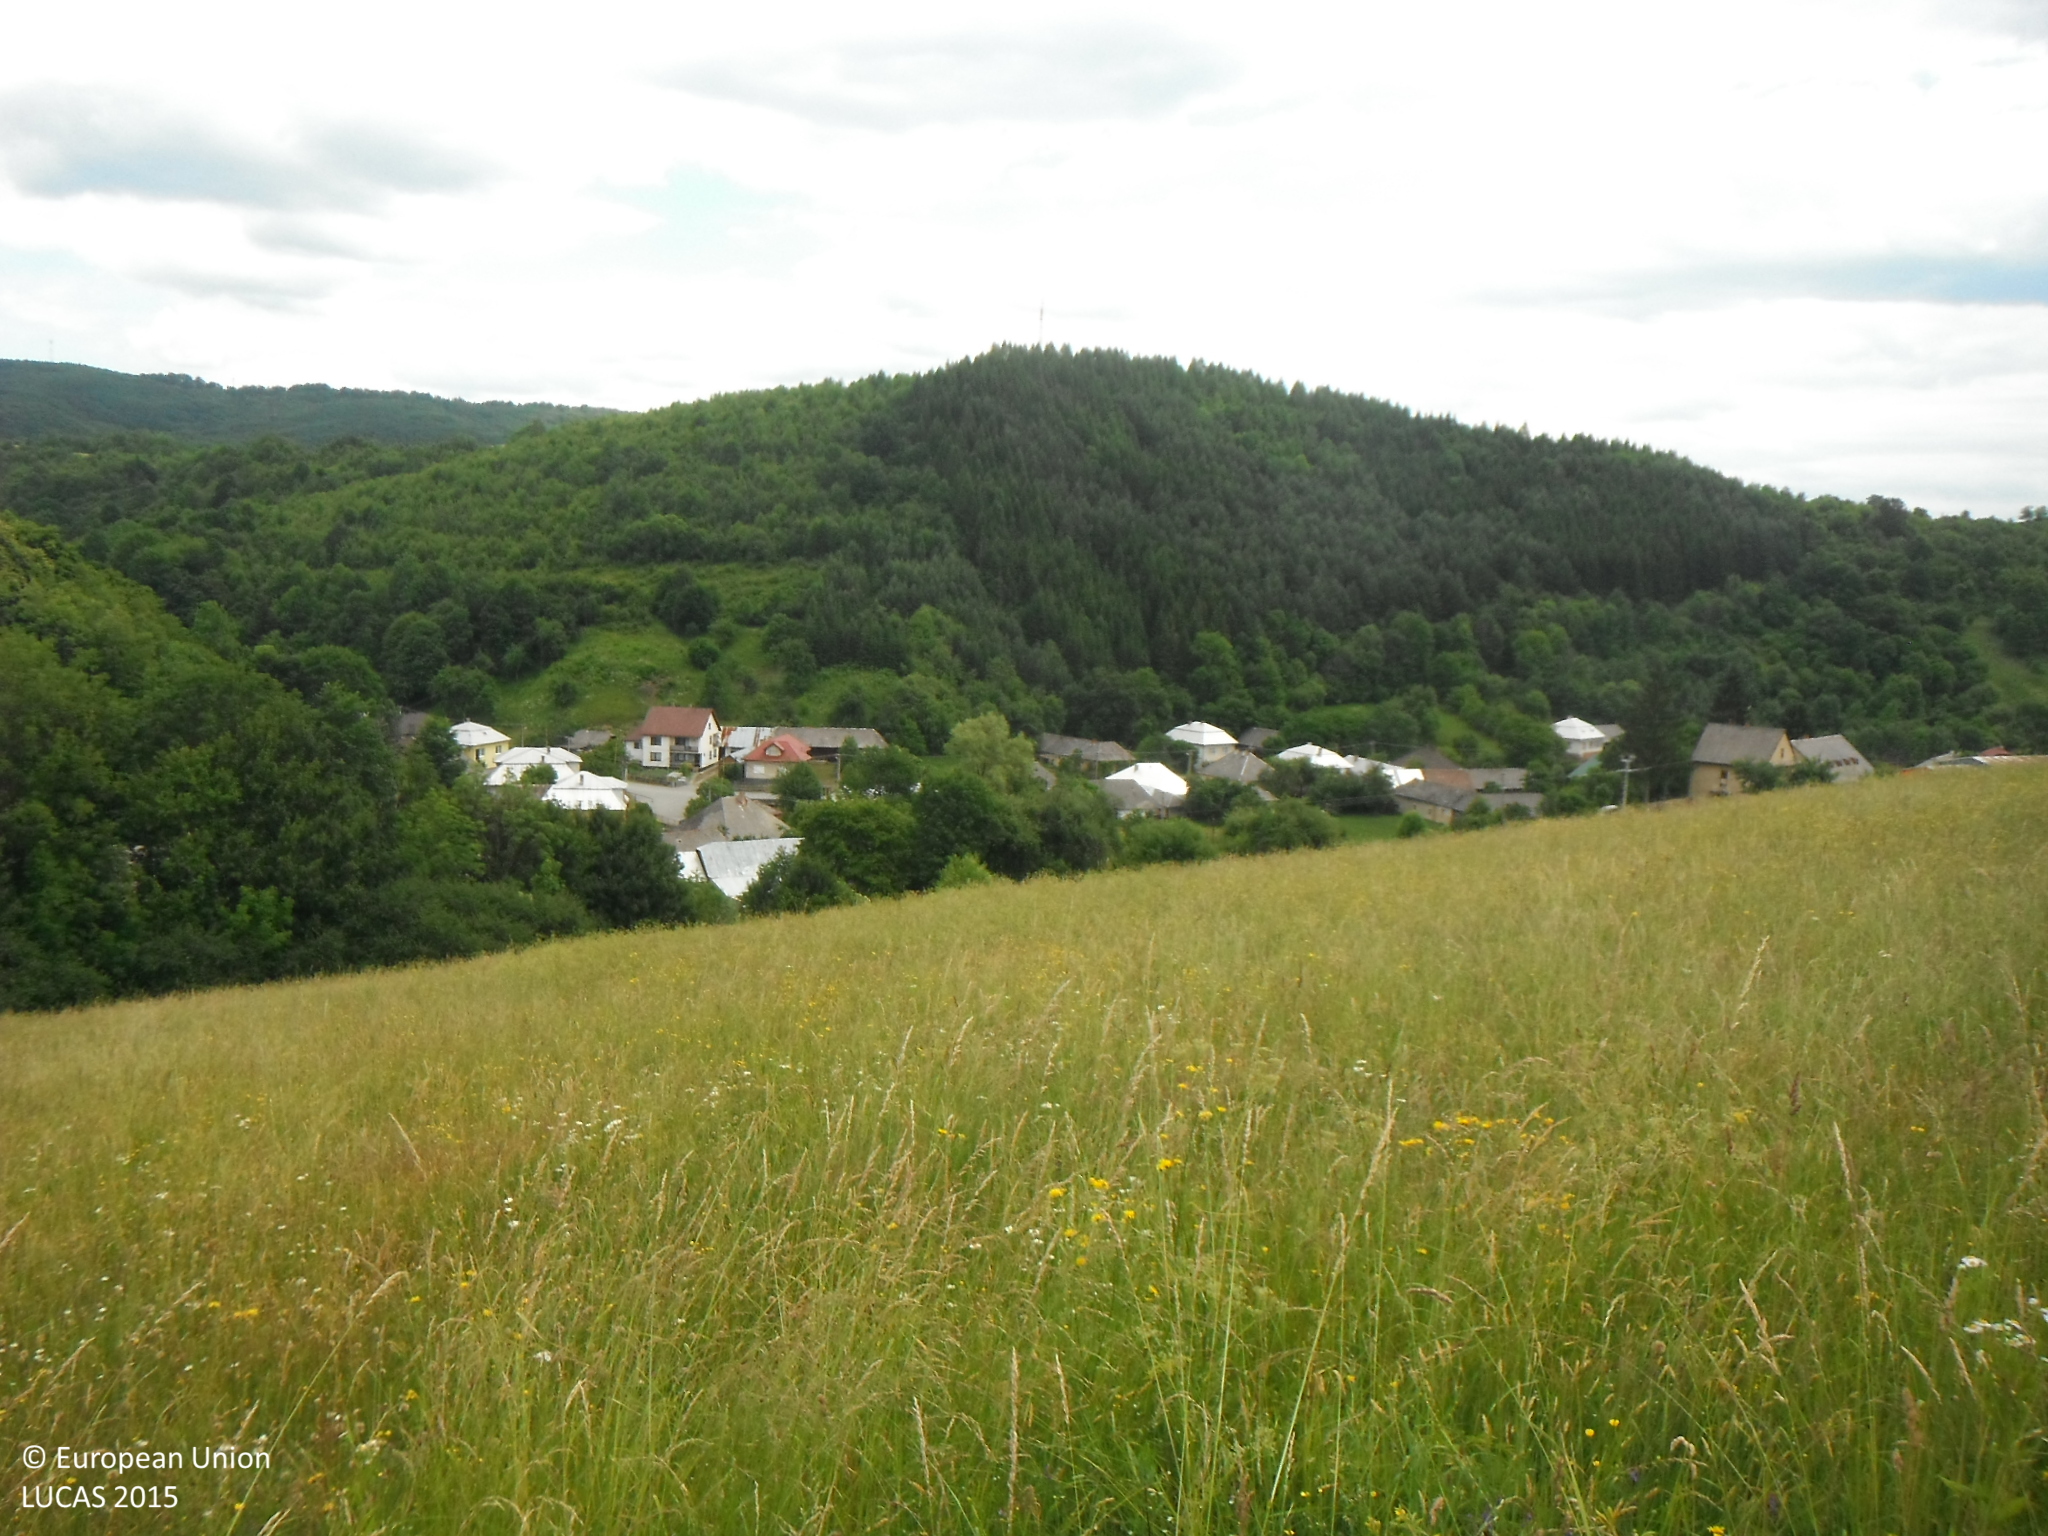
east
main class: Grassland
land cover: Grassland without tree/shrub cover
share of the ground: > 75 %
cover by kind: herbaceous plants 100 %
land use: Agriculture (excluding fallow land and kitchen gardens)
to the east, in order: Grassland without tree/shrub cover; Broadleaved woodland; Artificial constructions in urban areas; Rivers and streams; Artificial constructions in urban areas
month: June
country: SK
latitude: 48.9442
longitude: 22.3628
